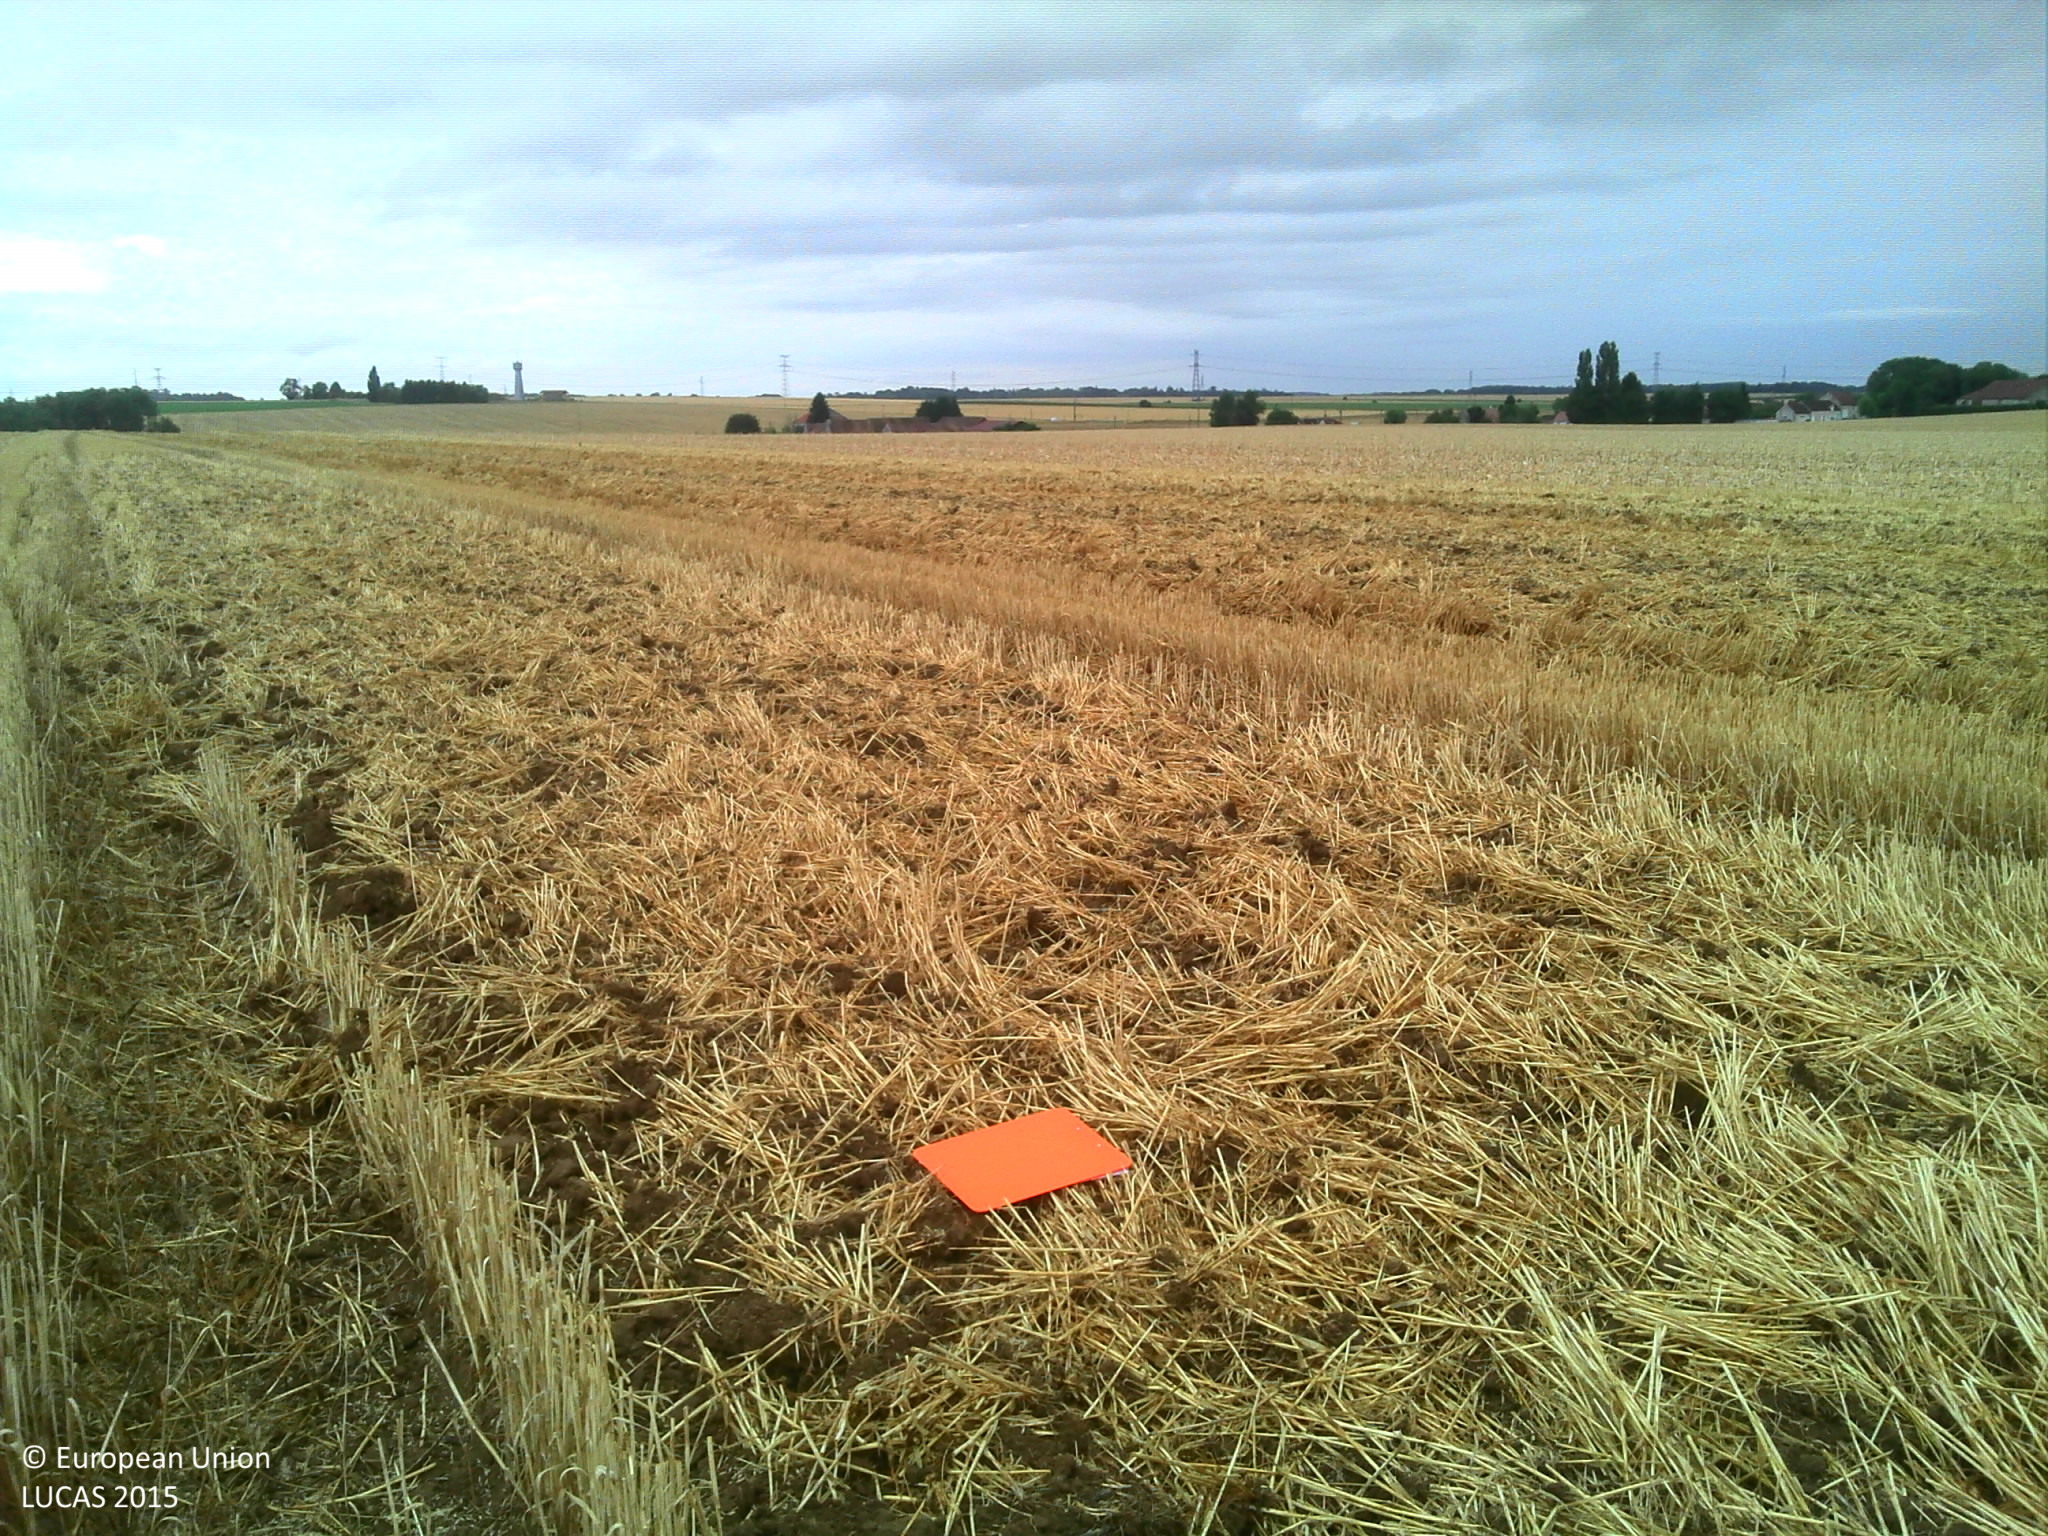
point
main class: Cropland
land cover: Common wheat
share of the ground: > 75 %
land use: Agriculture (excluding fallow land and kitchen gardens)
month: August
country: FR
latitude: 48.5637
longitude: 3.3398
